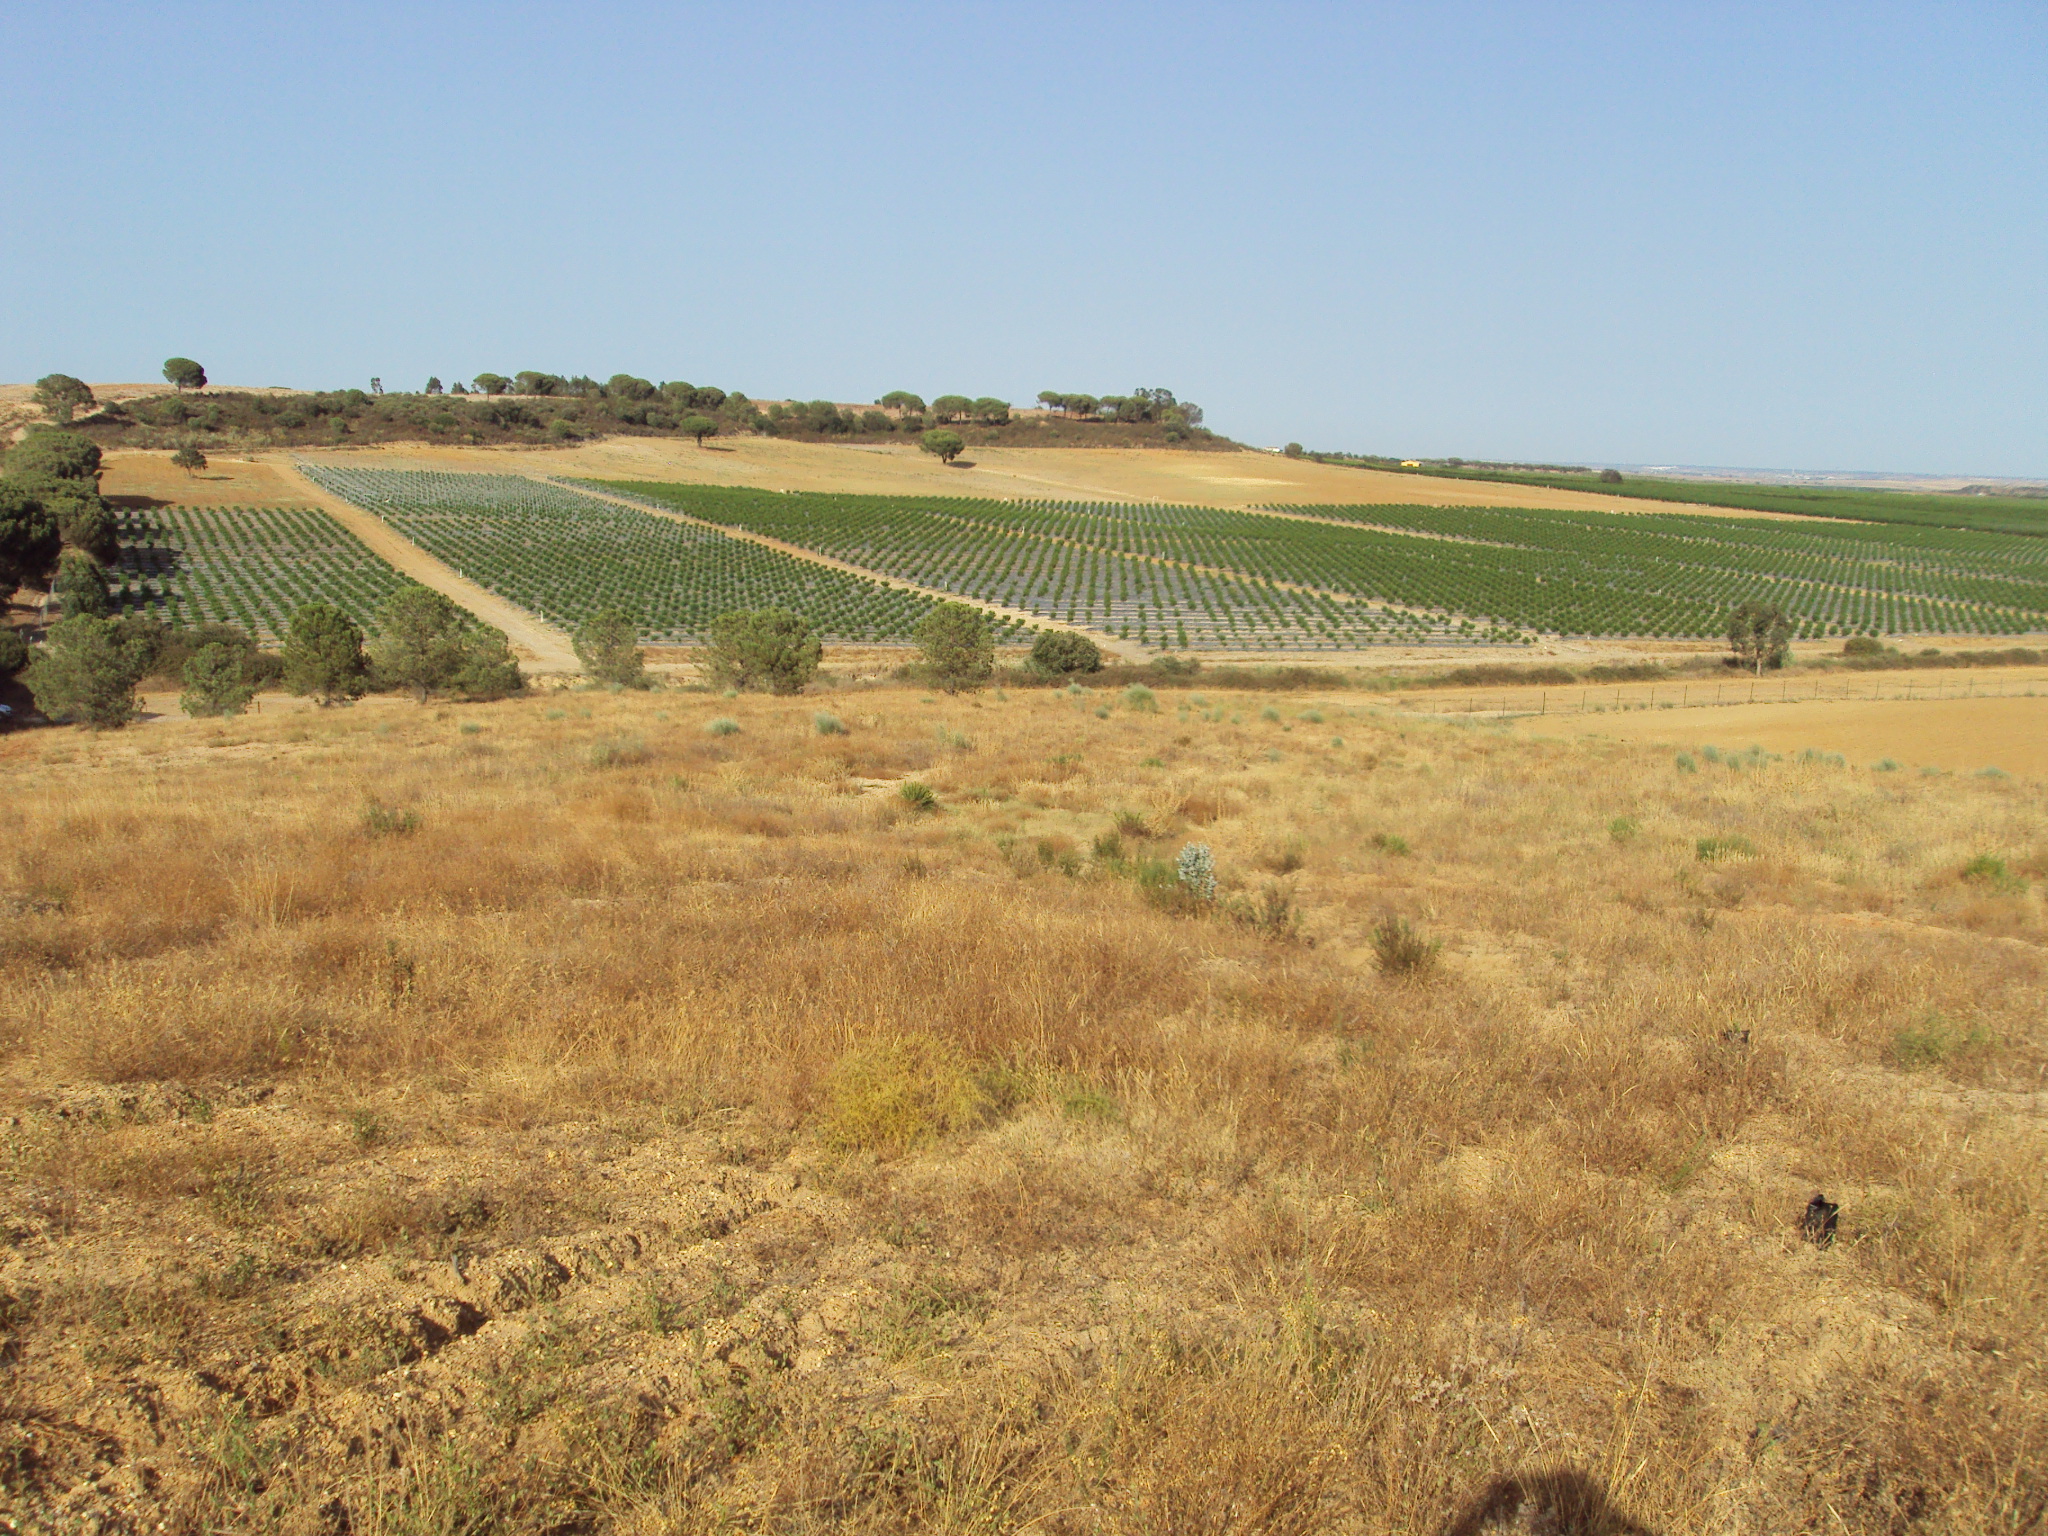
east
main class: Grassland
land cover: Spontaneously vegetated surfaces
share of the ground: > 75 %
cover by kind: herbaceous plants 65 %, unconsolidated bare surface 30 %, shrubs 5 %
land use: Agriculture (excluding fallow land and kitchen gardens)
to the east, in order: Spontaneously vegetated surfaces; Fences; Tracks; Grass margins; Barley; Shruby margins; Rivers and streams; Grass margins; Tracks; Shruby margins; Other fruit trees and berries
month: July
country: ES
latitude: 37.3367
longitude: -7.0743
